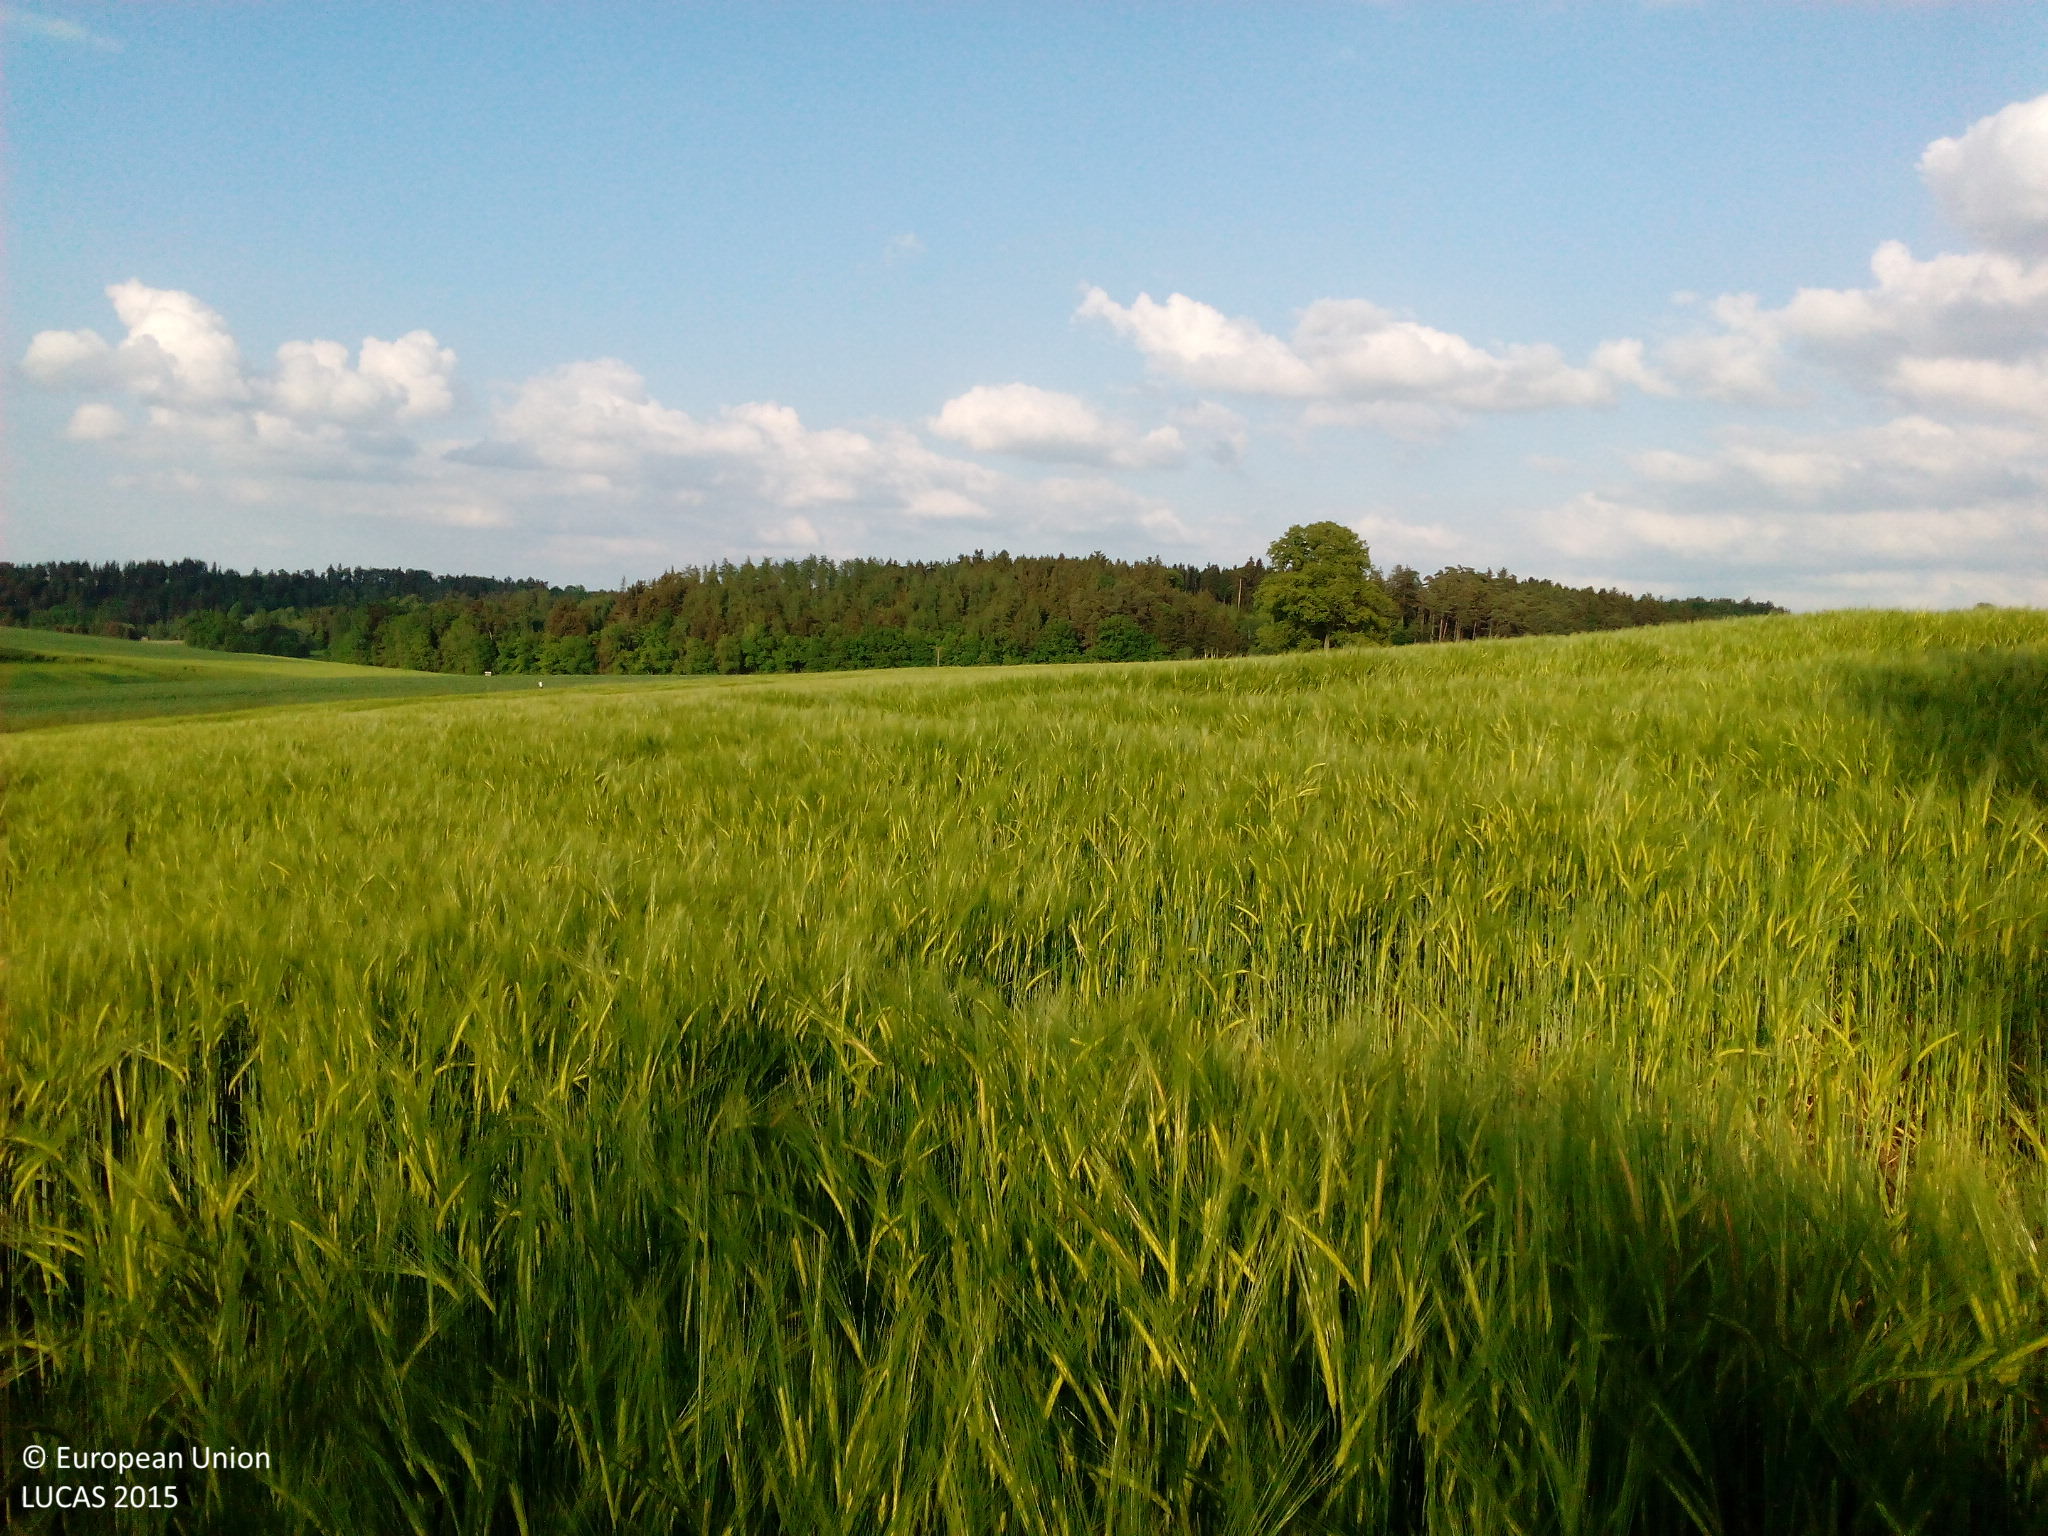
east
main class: Cropland
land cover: Barley
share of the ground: > 75 %
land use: Agriculture (excluding fallow land and kitchen gardens)
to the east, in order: Barley; Rape and turnip rape; Grassland without tree/shrub cover; Paved roads, cycling and walking lanes; Grass margins; Common wheat
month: May
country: DE
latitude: 48.5255
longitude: 12.2063
